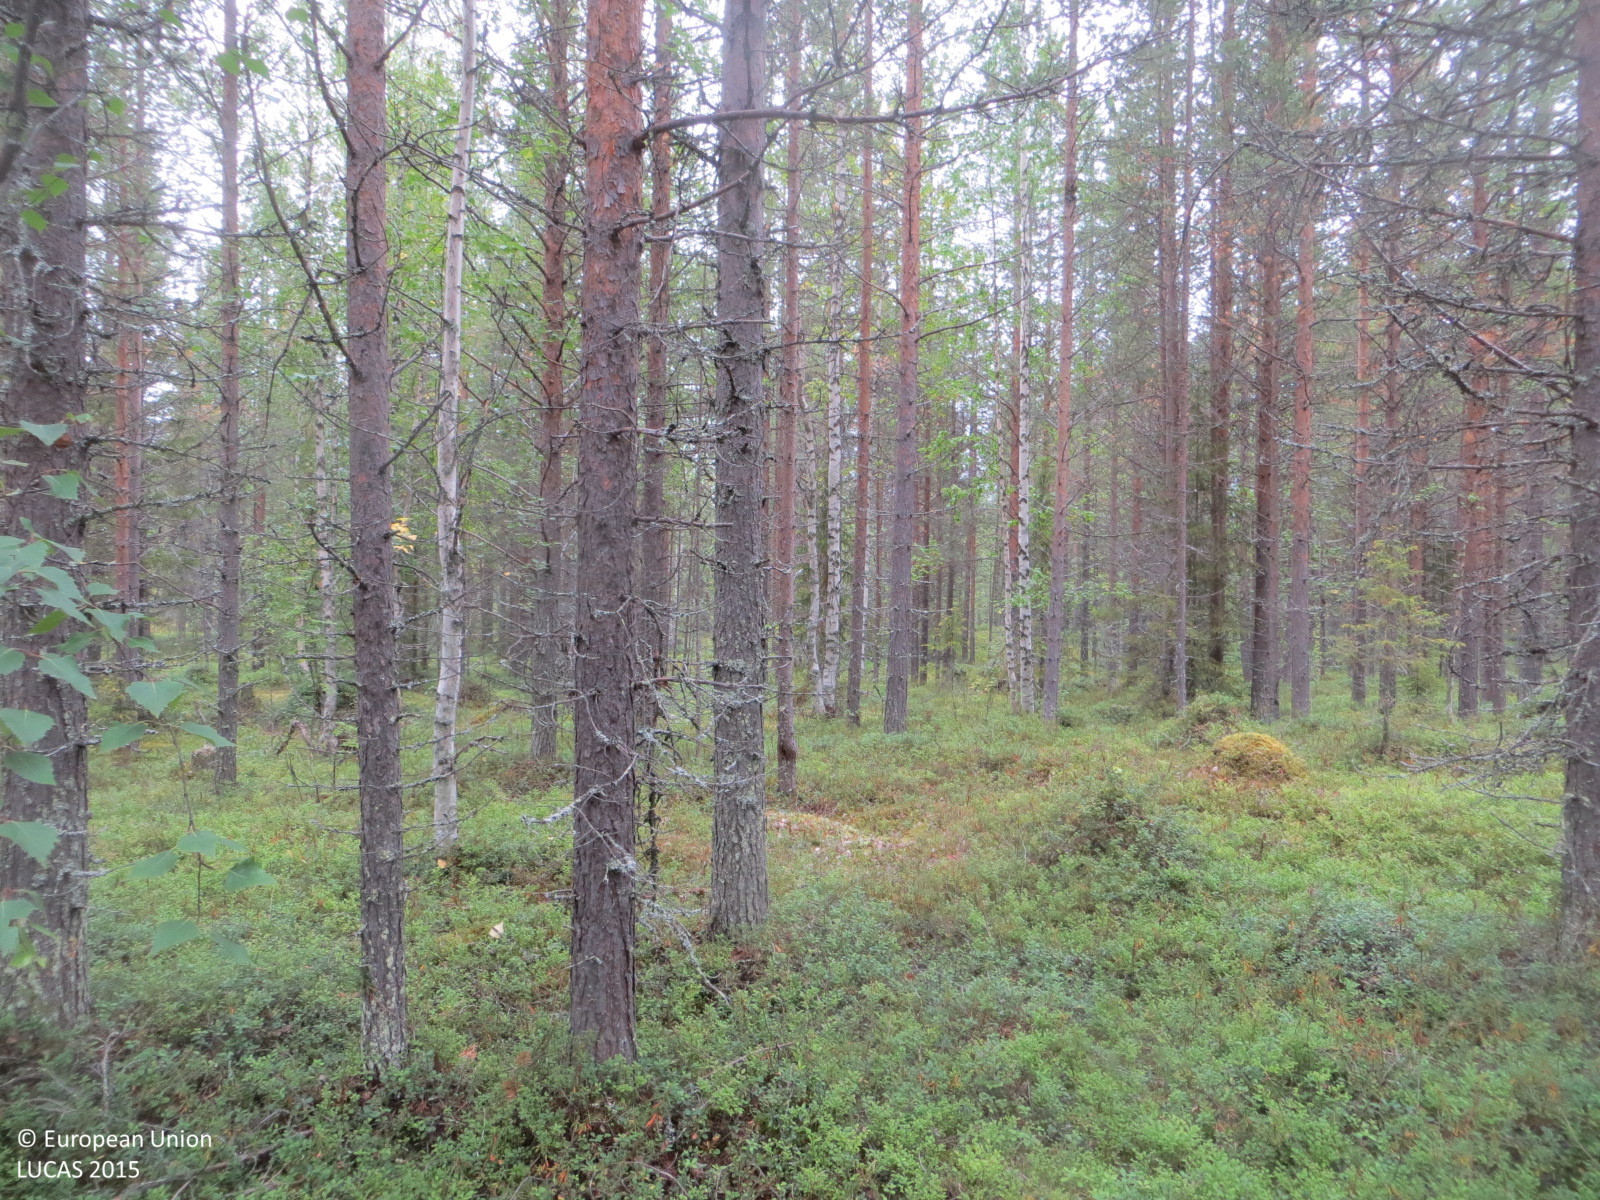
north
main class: Woodland
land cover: Pine dominated mixed woodland
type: boreal forest
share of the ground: 50 - 75 %
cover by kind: coniferous forest trees 45 %, shrubs 40 %, broadleaved forest trees 15 %
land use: Forestry
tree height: > 5 m
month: August
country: FI
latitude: 67.4198
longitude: 24.2877
